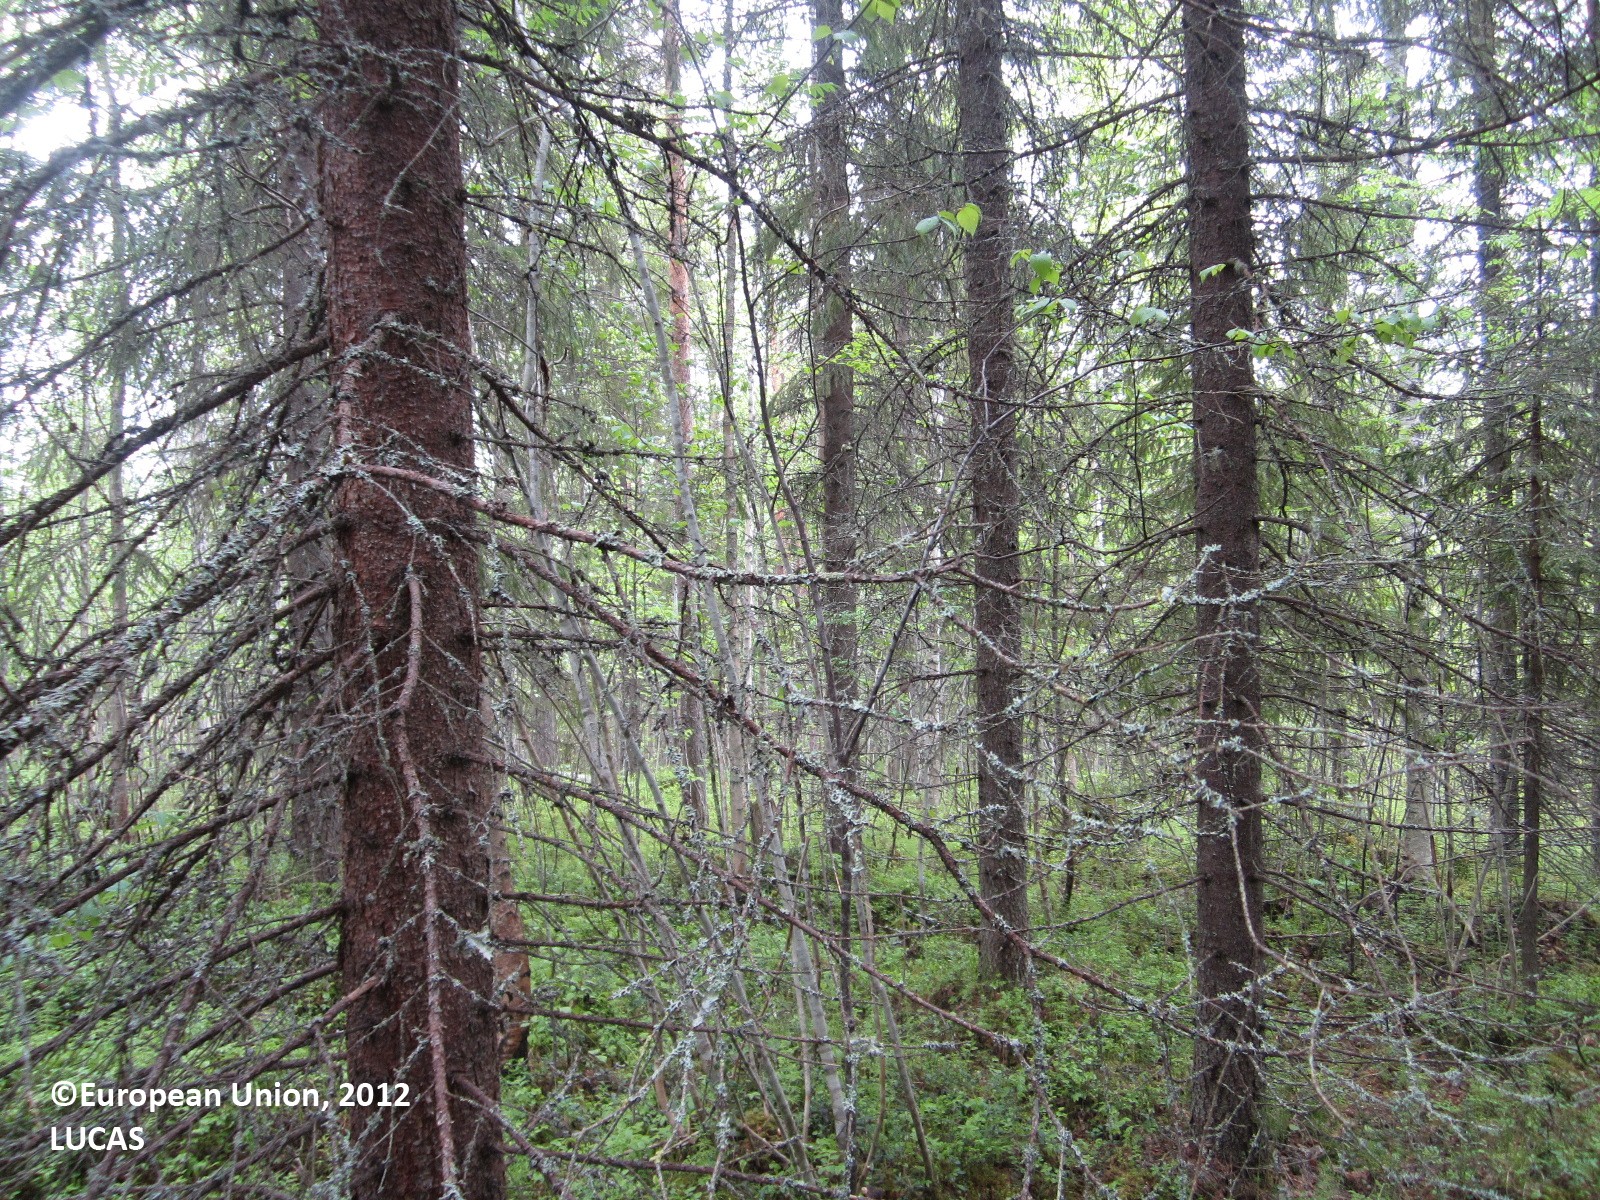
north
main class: Woodland
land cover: Pine dominated mixed woodland
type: boreal forest
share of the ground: > 75 %
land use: Forestry
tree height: > 5 m
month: June
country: FI
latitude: 64.6172
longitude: 28.6846
